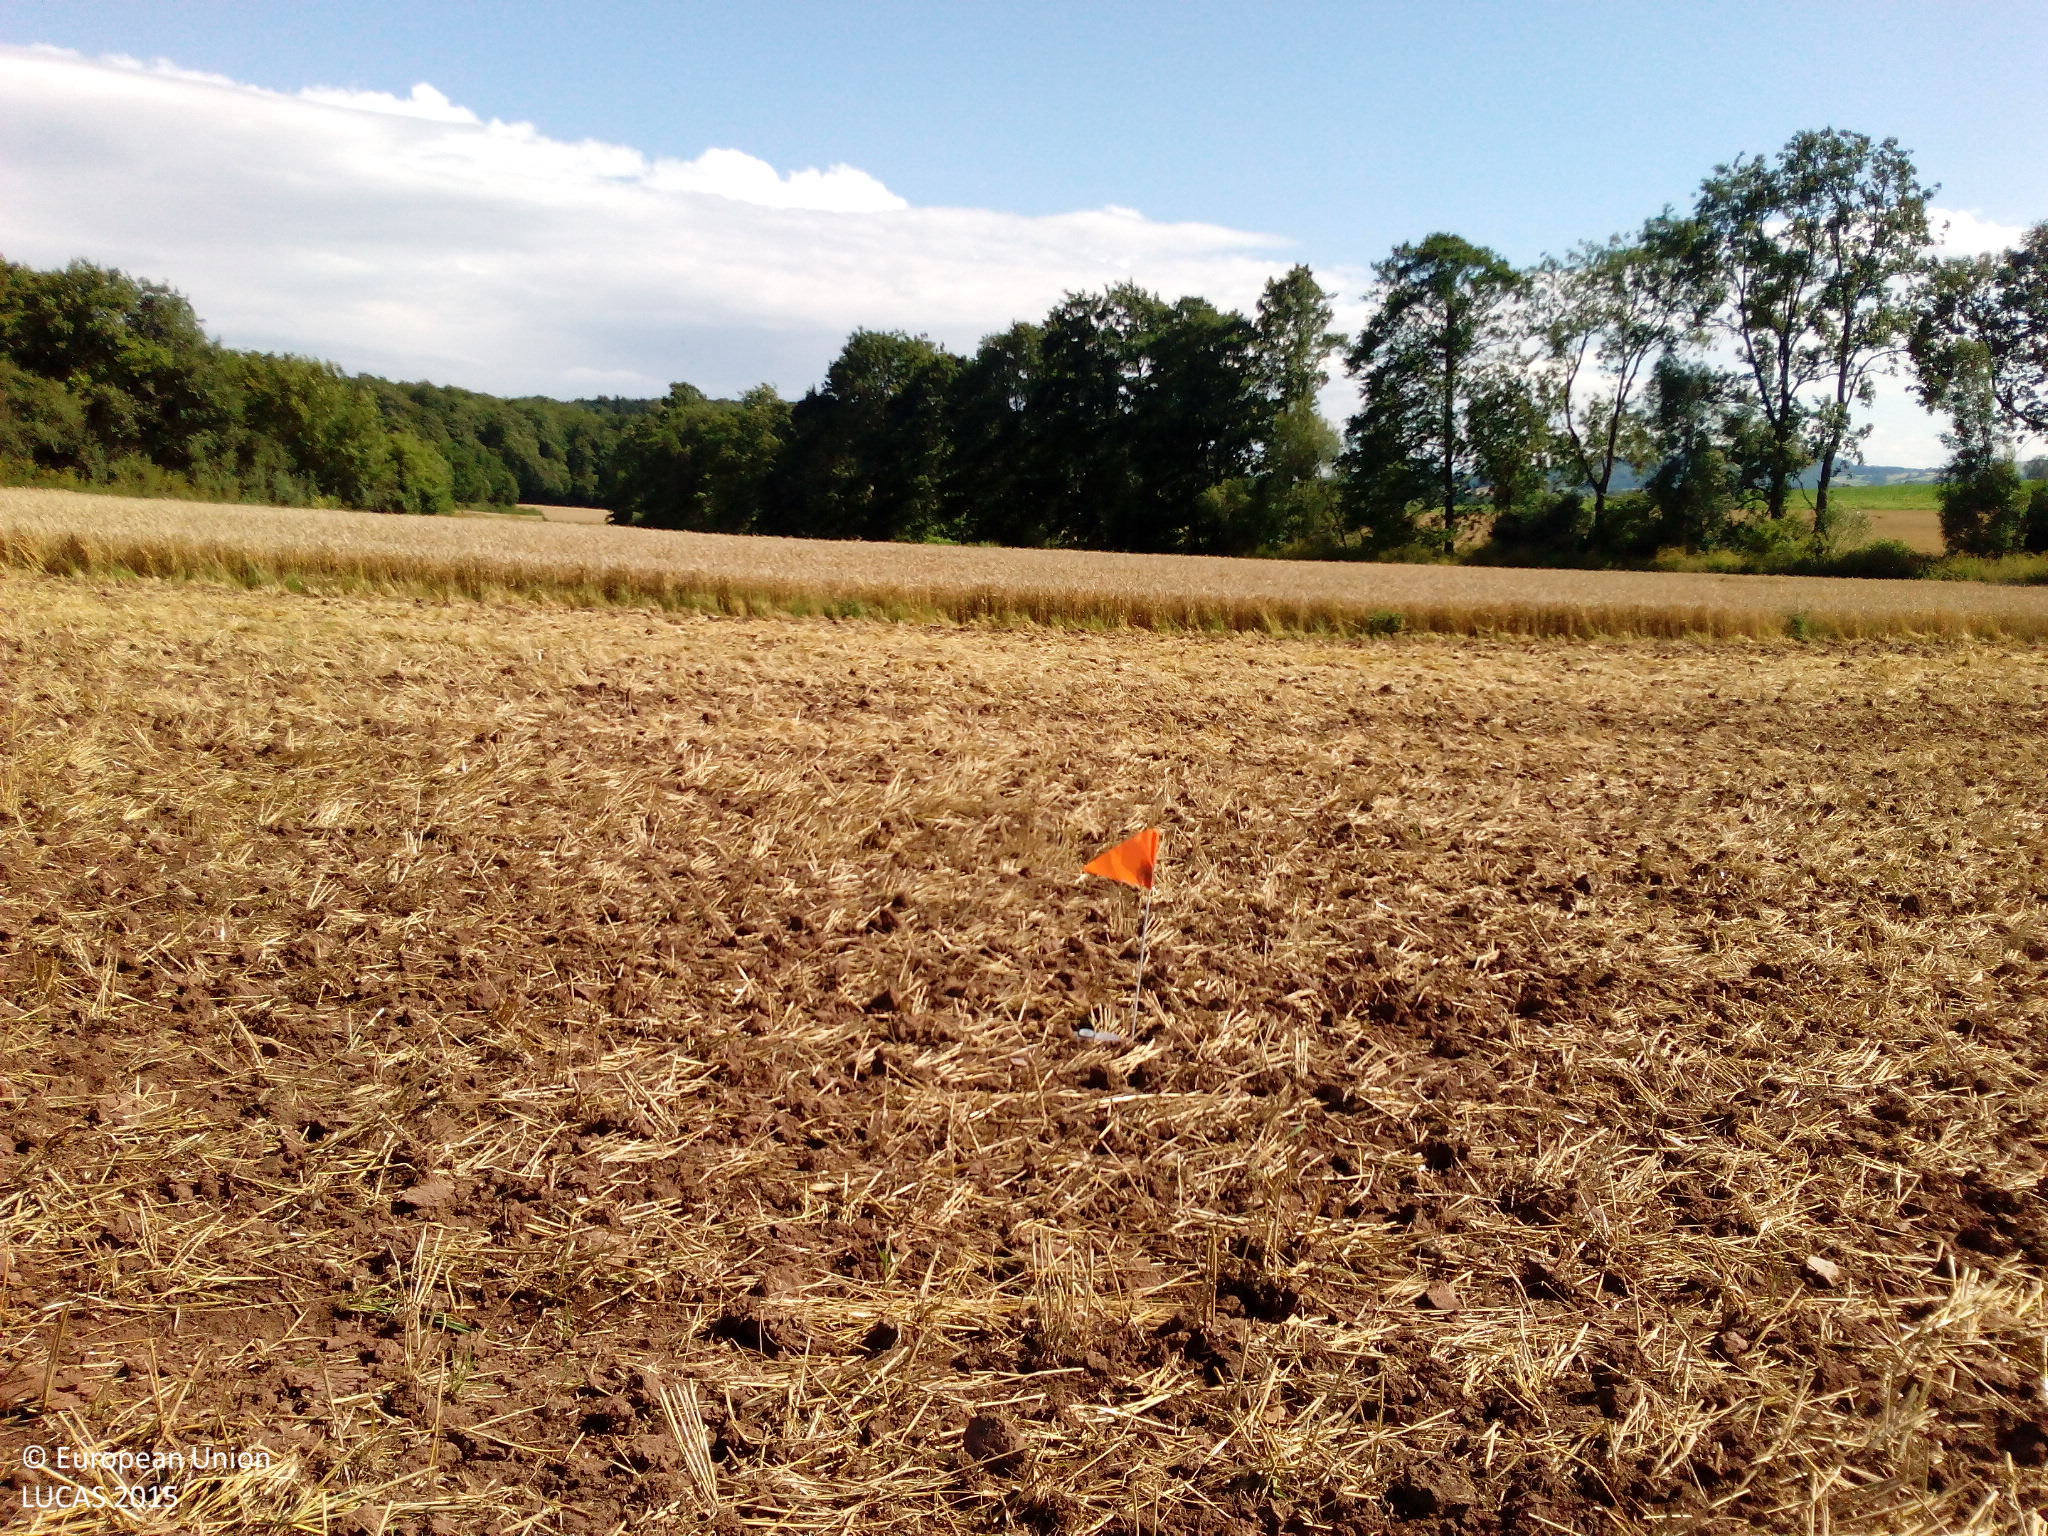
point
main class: Cropland
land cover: Barley
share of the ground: < 10 %
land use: Agriculture (excluding fallow land and kitchen gardens)
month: July
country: DE
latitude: 51.4230
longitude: 9.3530
